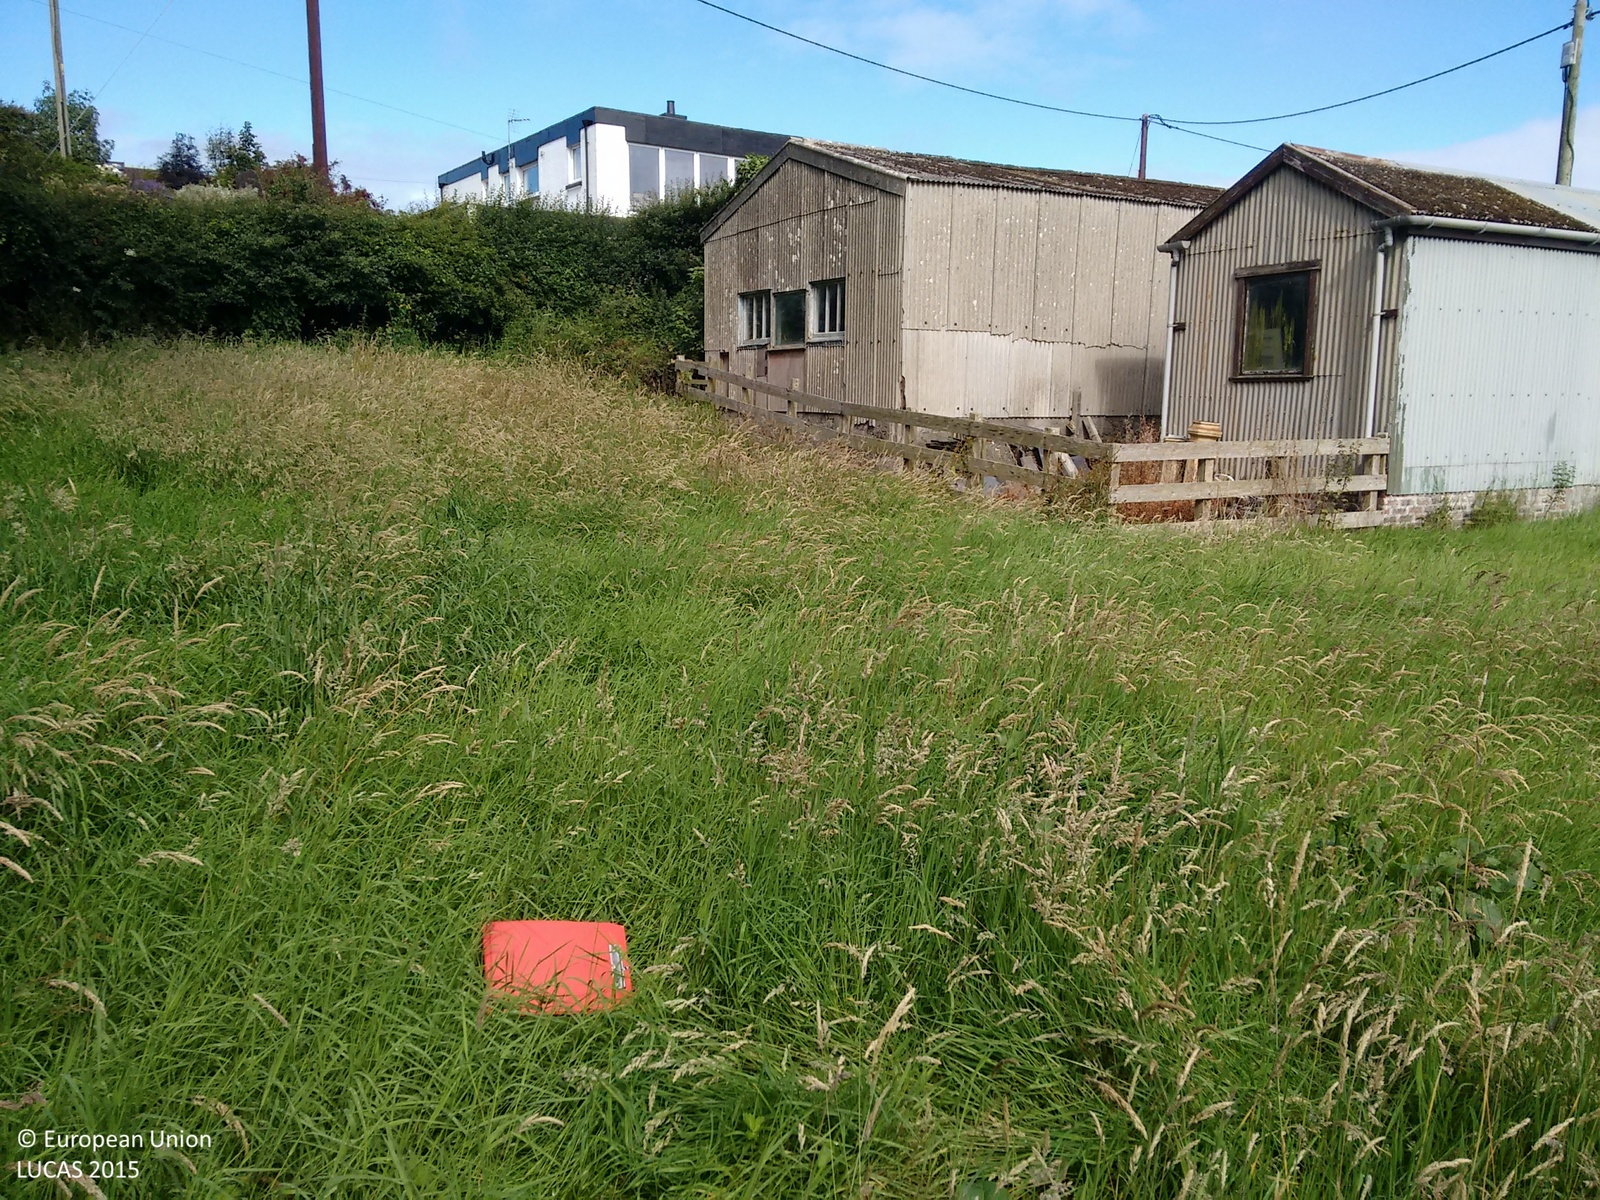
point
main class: Grassland
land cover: Grassland with sparse tree/shrub cover
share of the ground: > 75 %
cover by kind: herbaceous plants 95 %, broadleaved forest trees 5 %
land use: Agriculture (excluding fallow land and kitchen gardens)
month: August
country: GB
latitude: 54.6885
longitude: -4.8956
